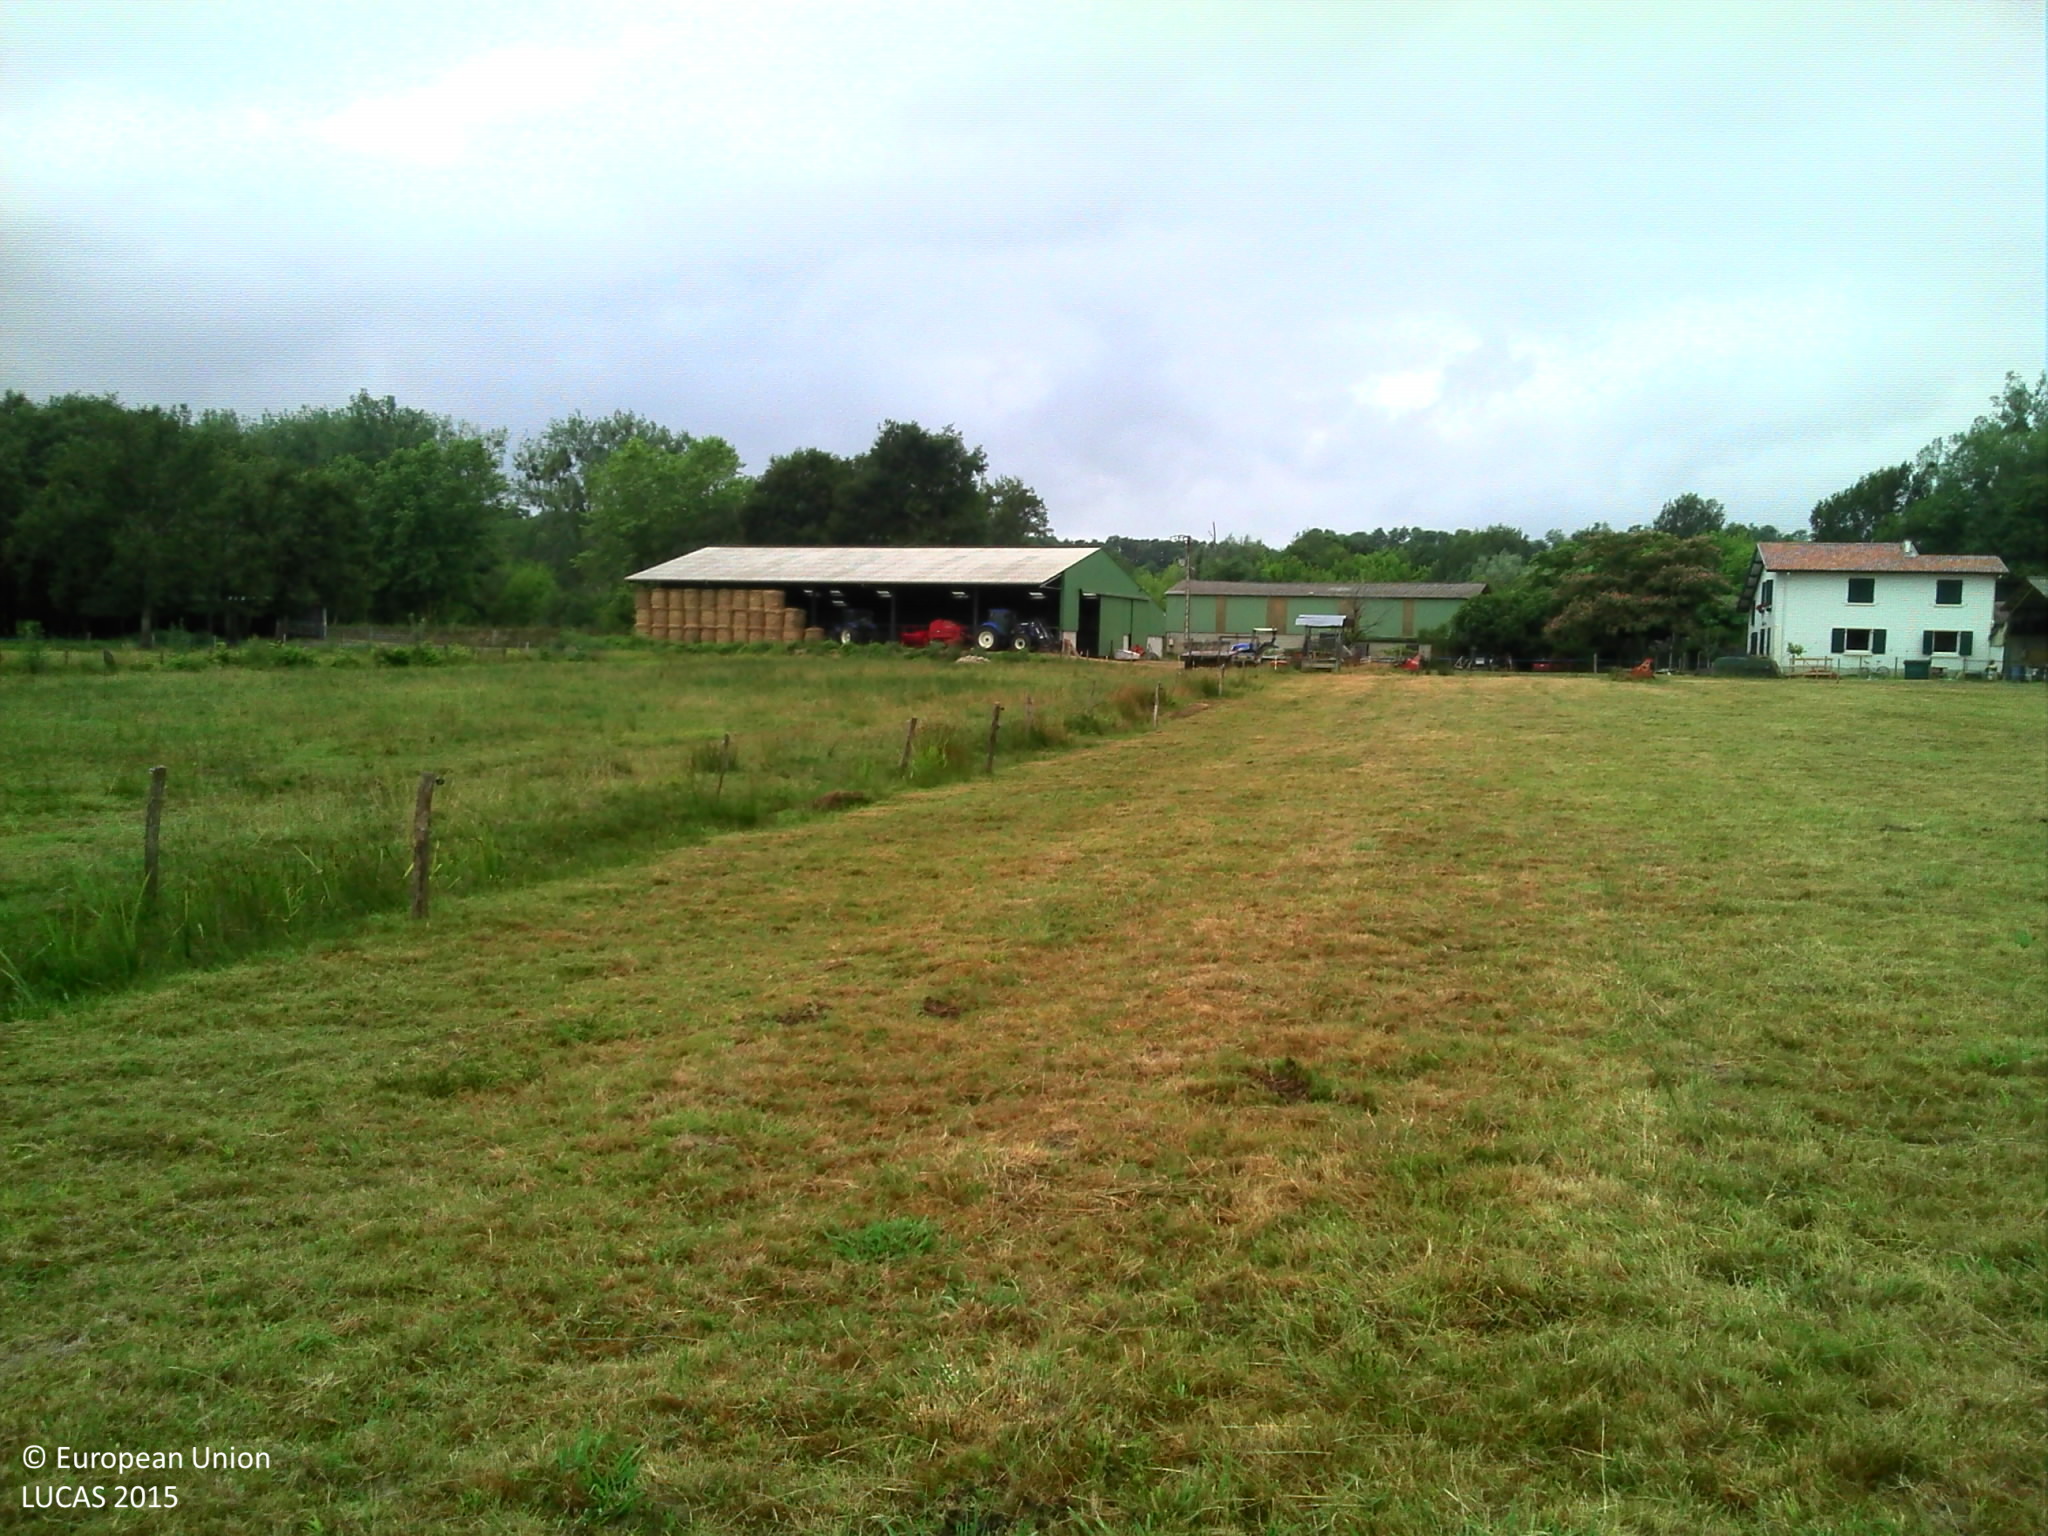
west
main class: Grassland
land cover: Grassland without tree/shrub cover
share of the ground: > 75 %
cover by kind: herbaceous plants 100 %
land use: Agriculture (excluding fallow land and kitchen gardens)
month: July
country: FR
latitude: 43.6116
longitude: -1.2299
